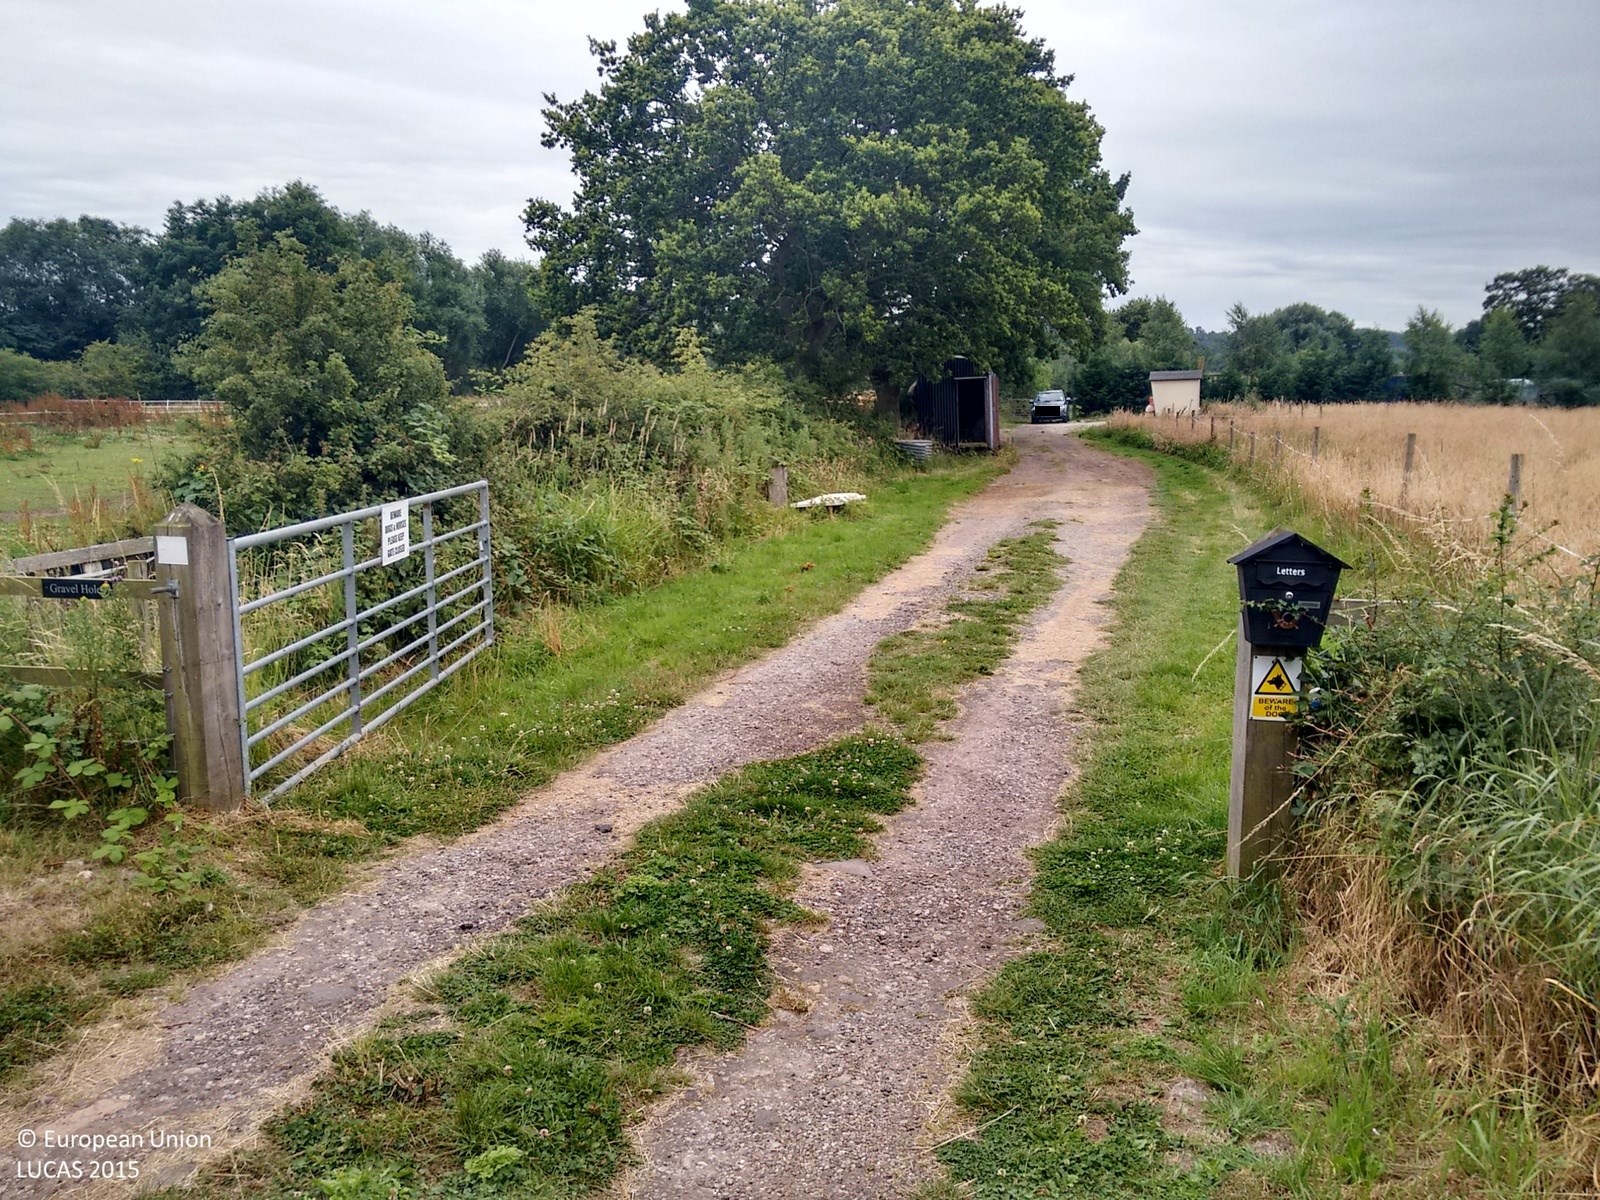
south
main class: Grassland
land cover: Grassland without tree/shrub cover
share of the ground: > 75 %
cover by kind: herbaceous plants 100 %
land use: Agriculture (excluding fallow land and kitchen gardens)
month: July
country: GB
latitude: 53.0969
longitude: -1.0206
